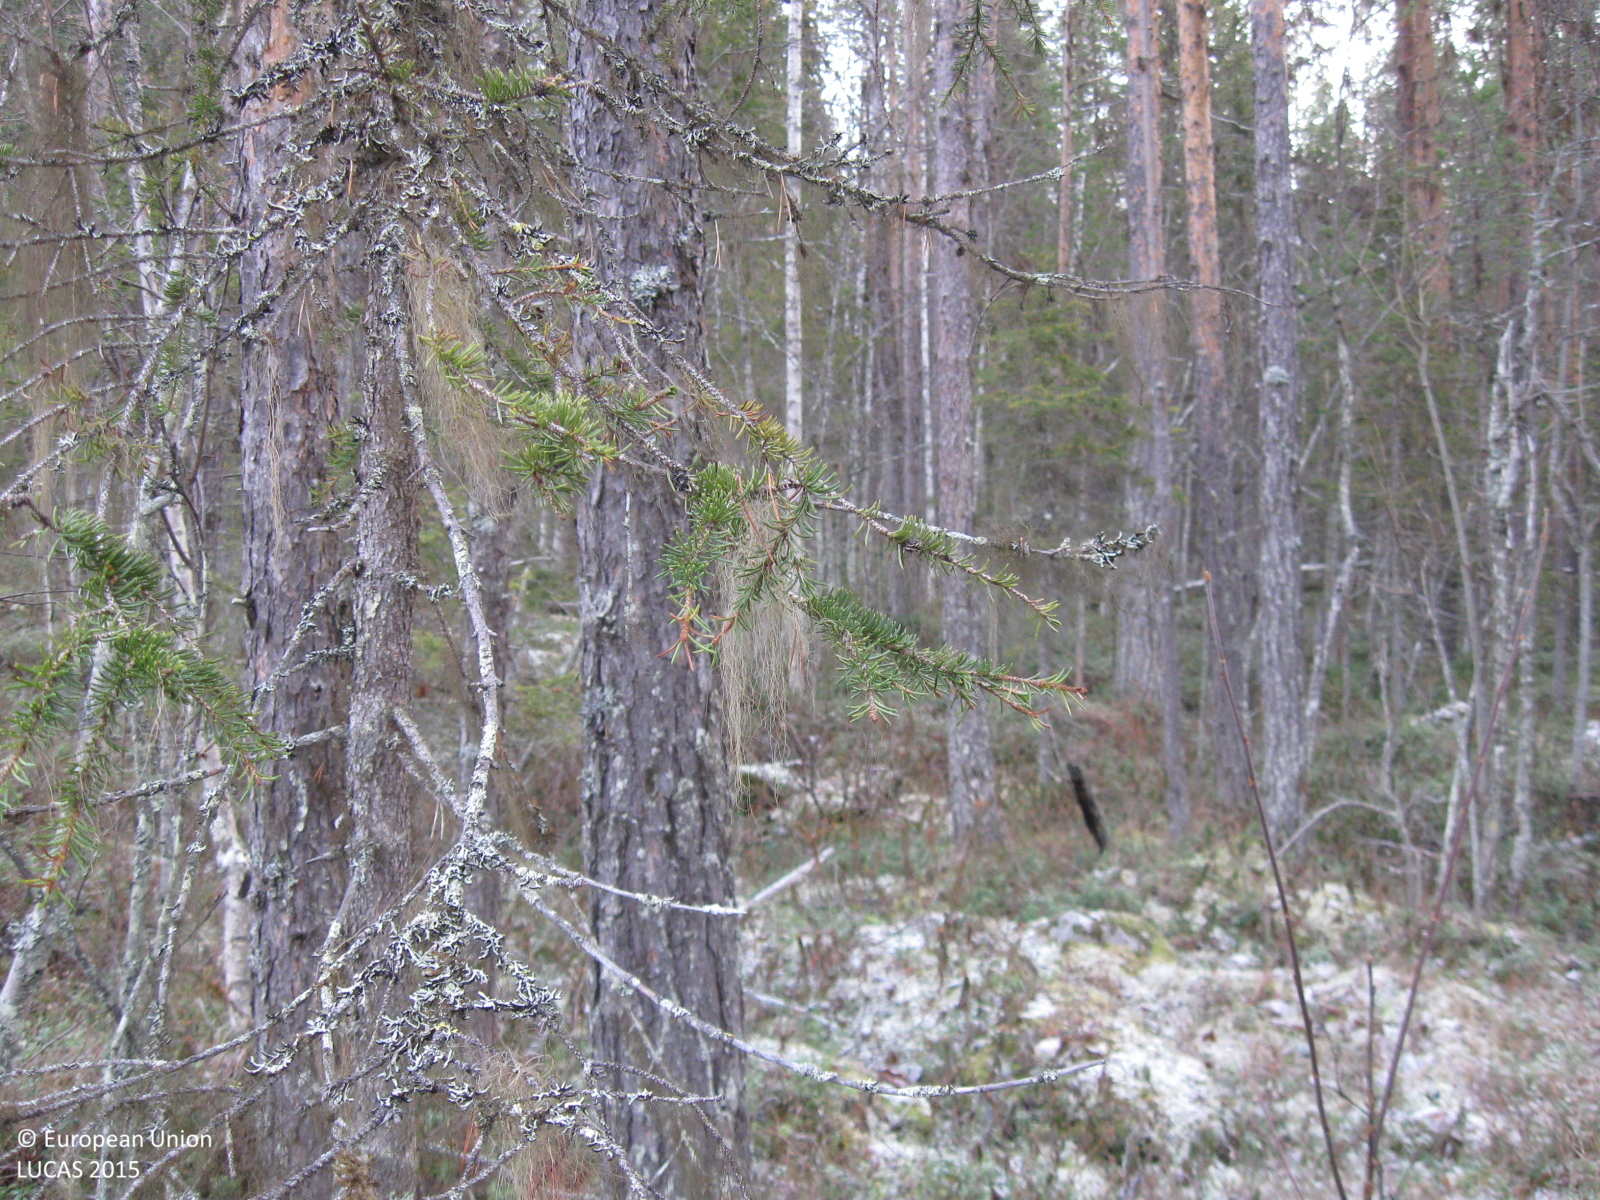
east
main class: Woodland
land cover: Pine dominated mixed woodland
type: boreal forest
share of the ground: 50 - 75 %
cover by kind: coniferous forest trees 45 %, broadleaved forest trees 25 %, unconsolidated bare surface 15 %, shrubs 5 %, herbaceous plants 5 %, lichens and mosses 5 %
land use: Forestry
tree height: > 5 m
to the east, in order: Pine dominated mixed woodland; Other mixed woodland
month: October
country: SE
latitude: 66.2213
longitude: 21.6357
